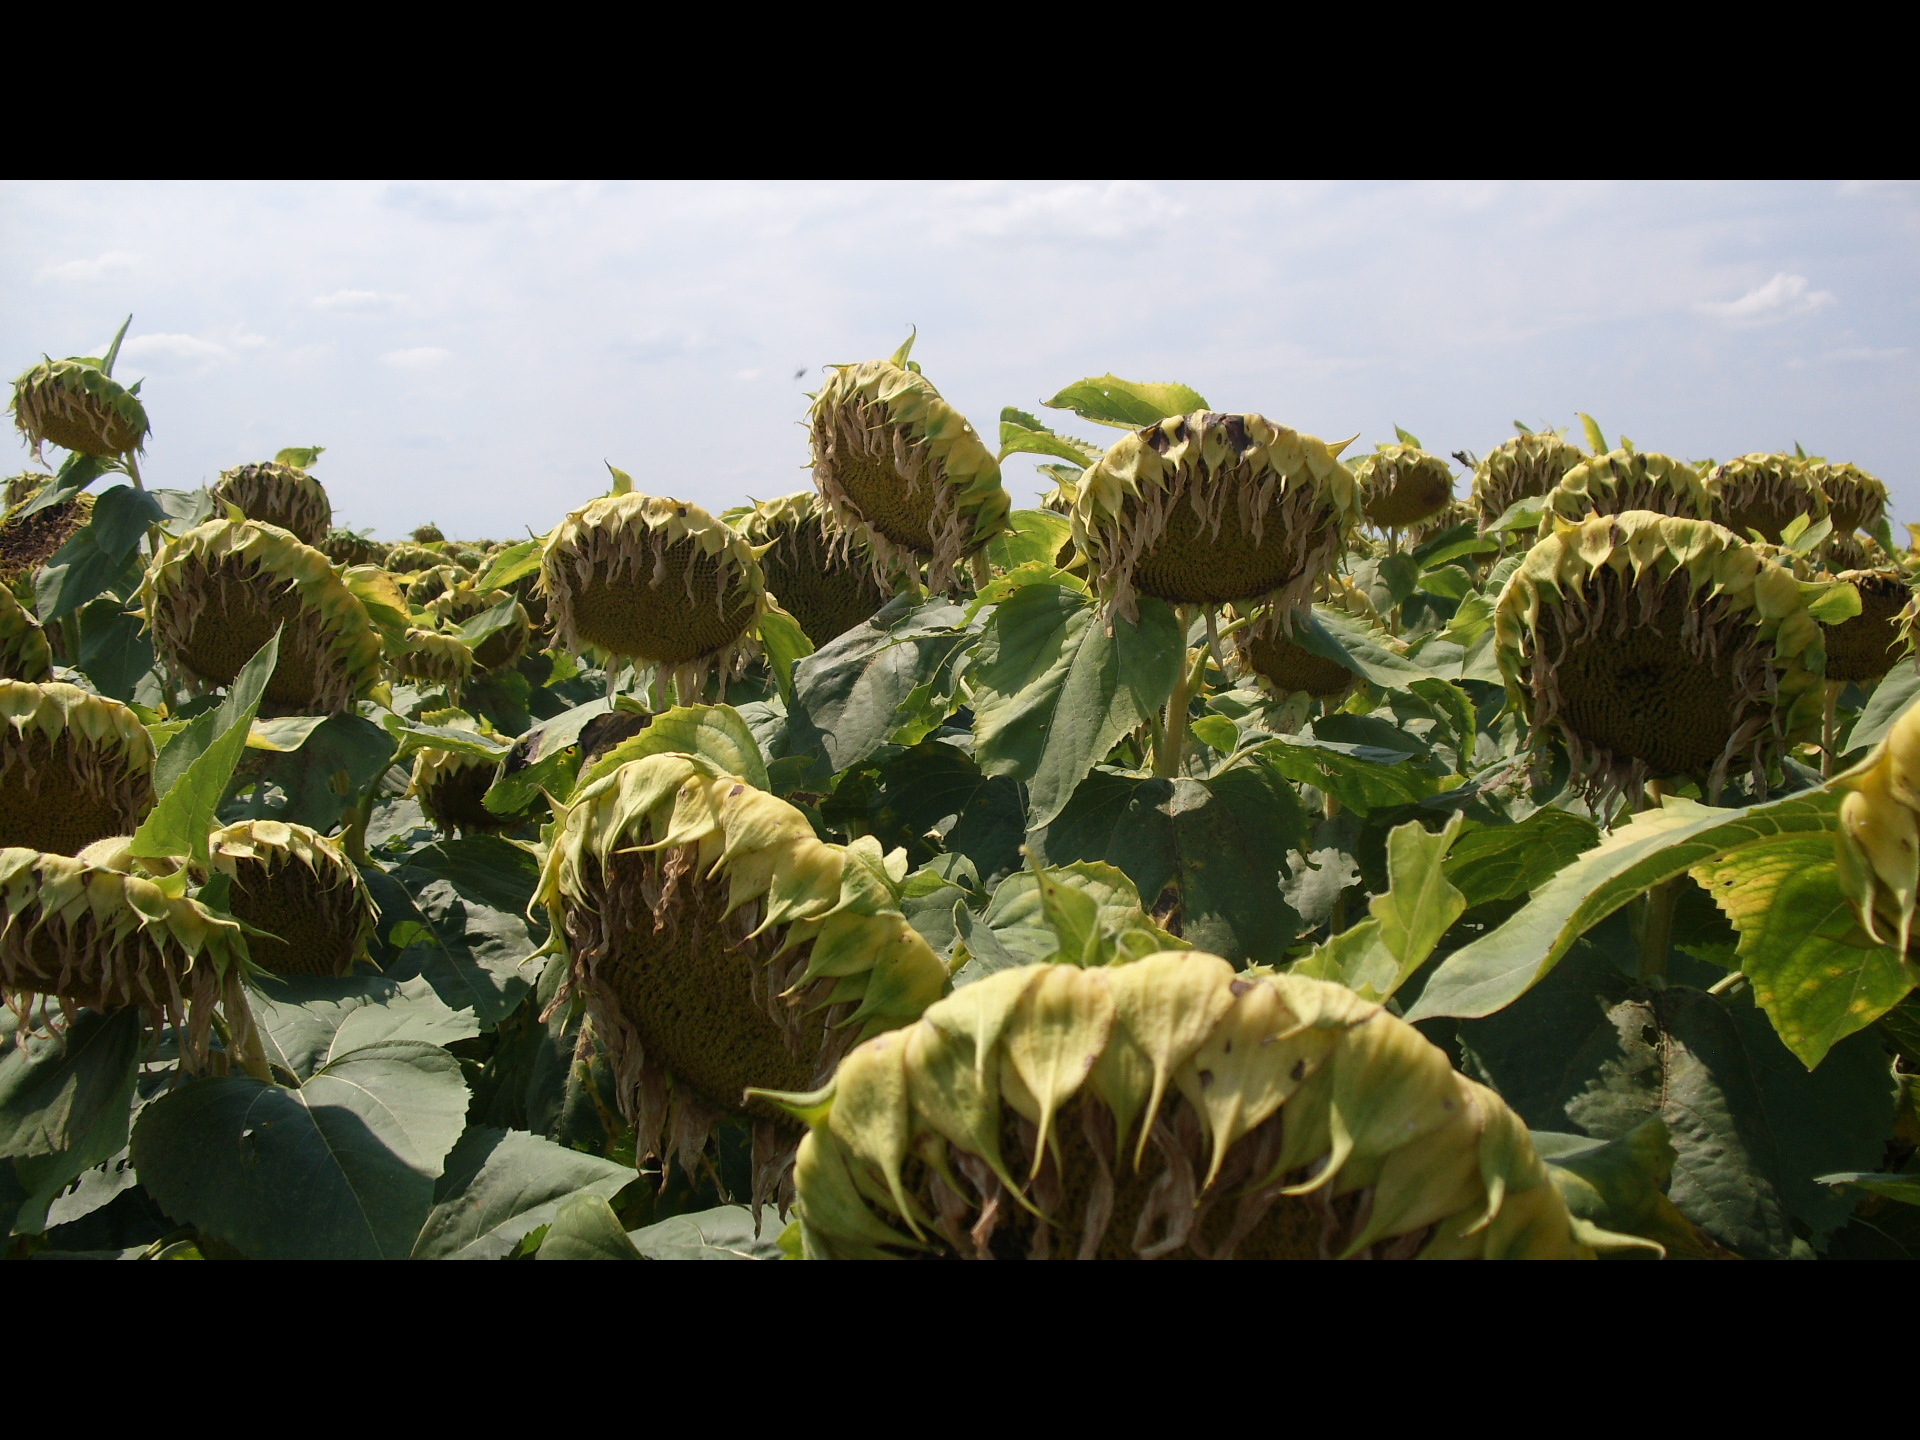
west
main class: Cropland
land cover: Sunflower
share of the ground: > 75 %
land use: Agriculture (excluding fallow land and kitchen gardens)
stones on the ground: < 10 %
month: July
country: BG
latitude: 43.7610
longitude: 23.6000
